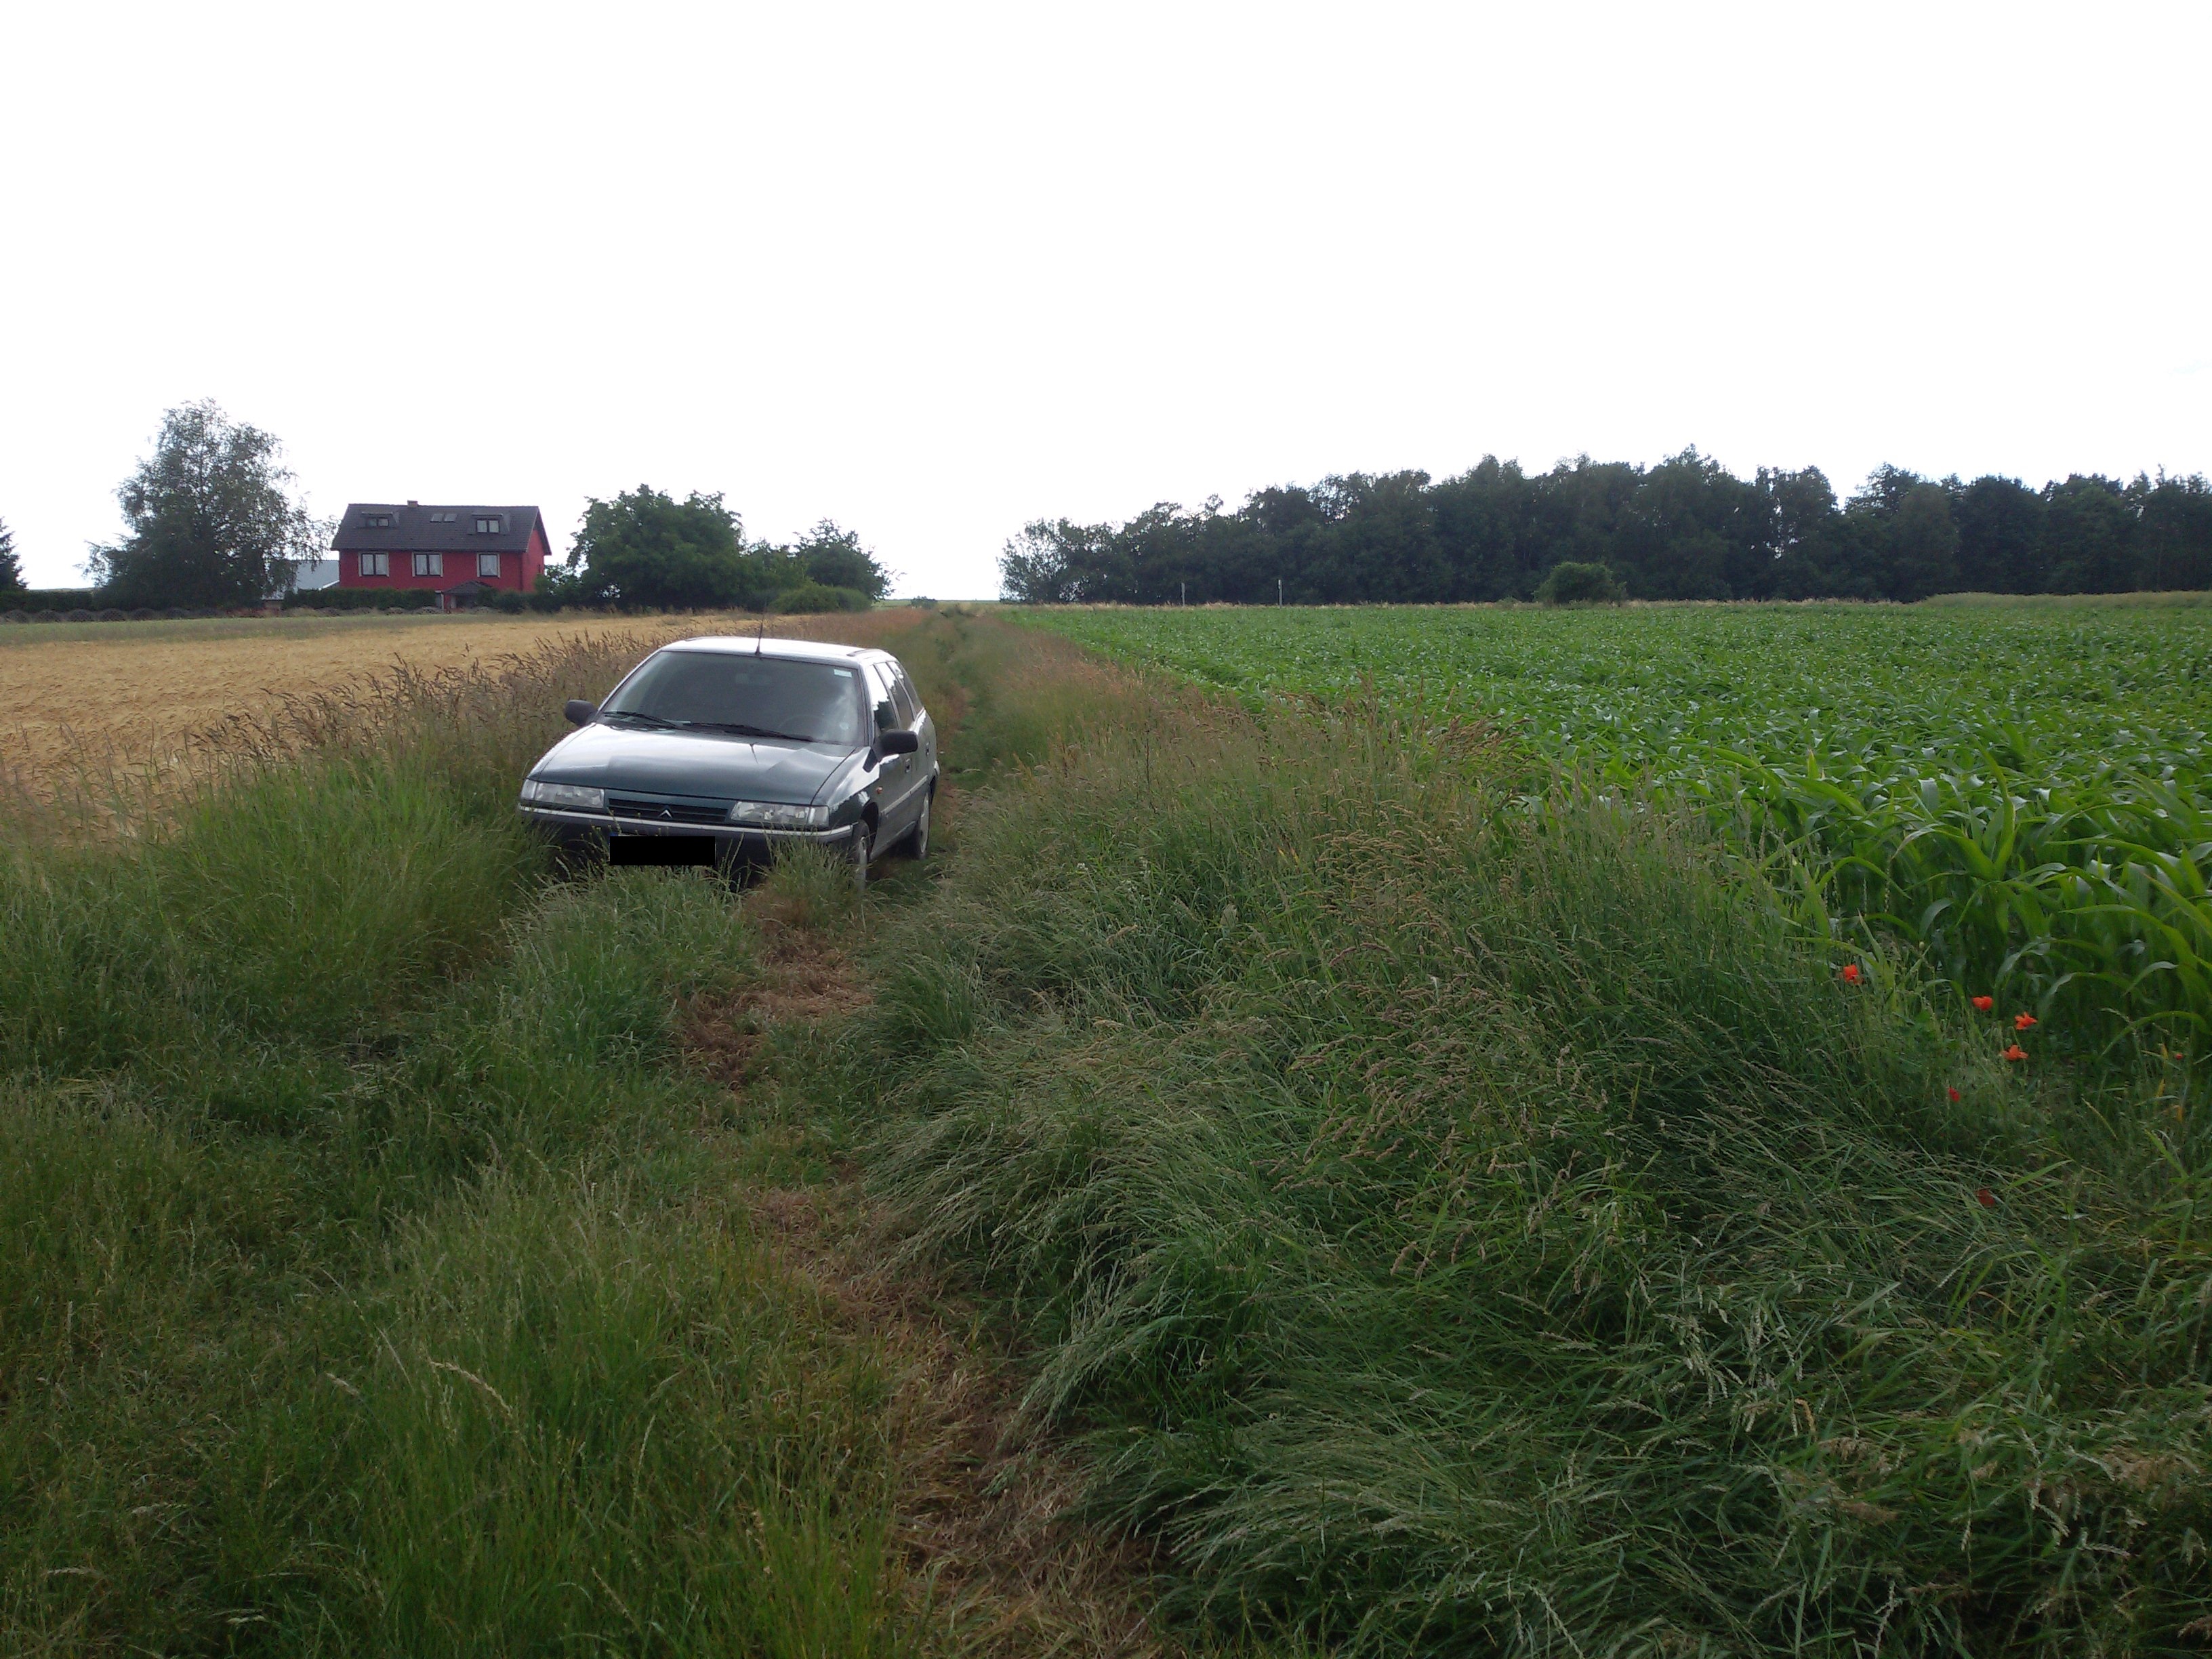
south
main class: Cropland
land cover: Rape and turnip rape
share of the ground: > 75 %
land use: Agriculture (excluding fallow land and kitchen gardens)
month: June
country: PL
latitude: 50.6956
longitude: 17.2171
